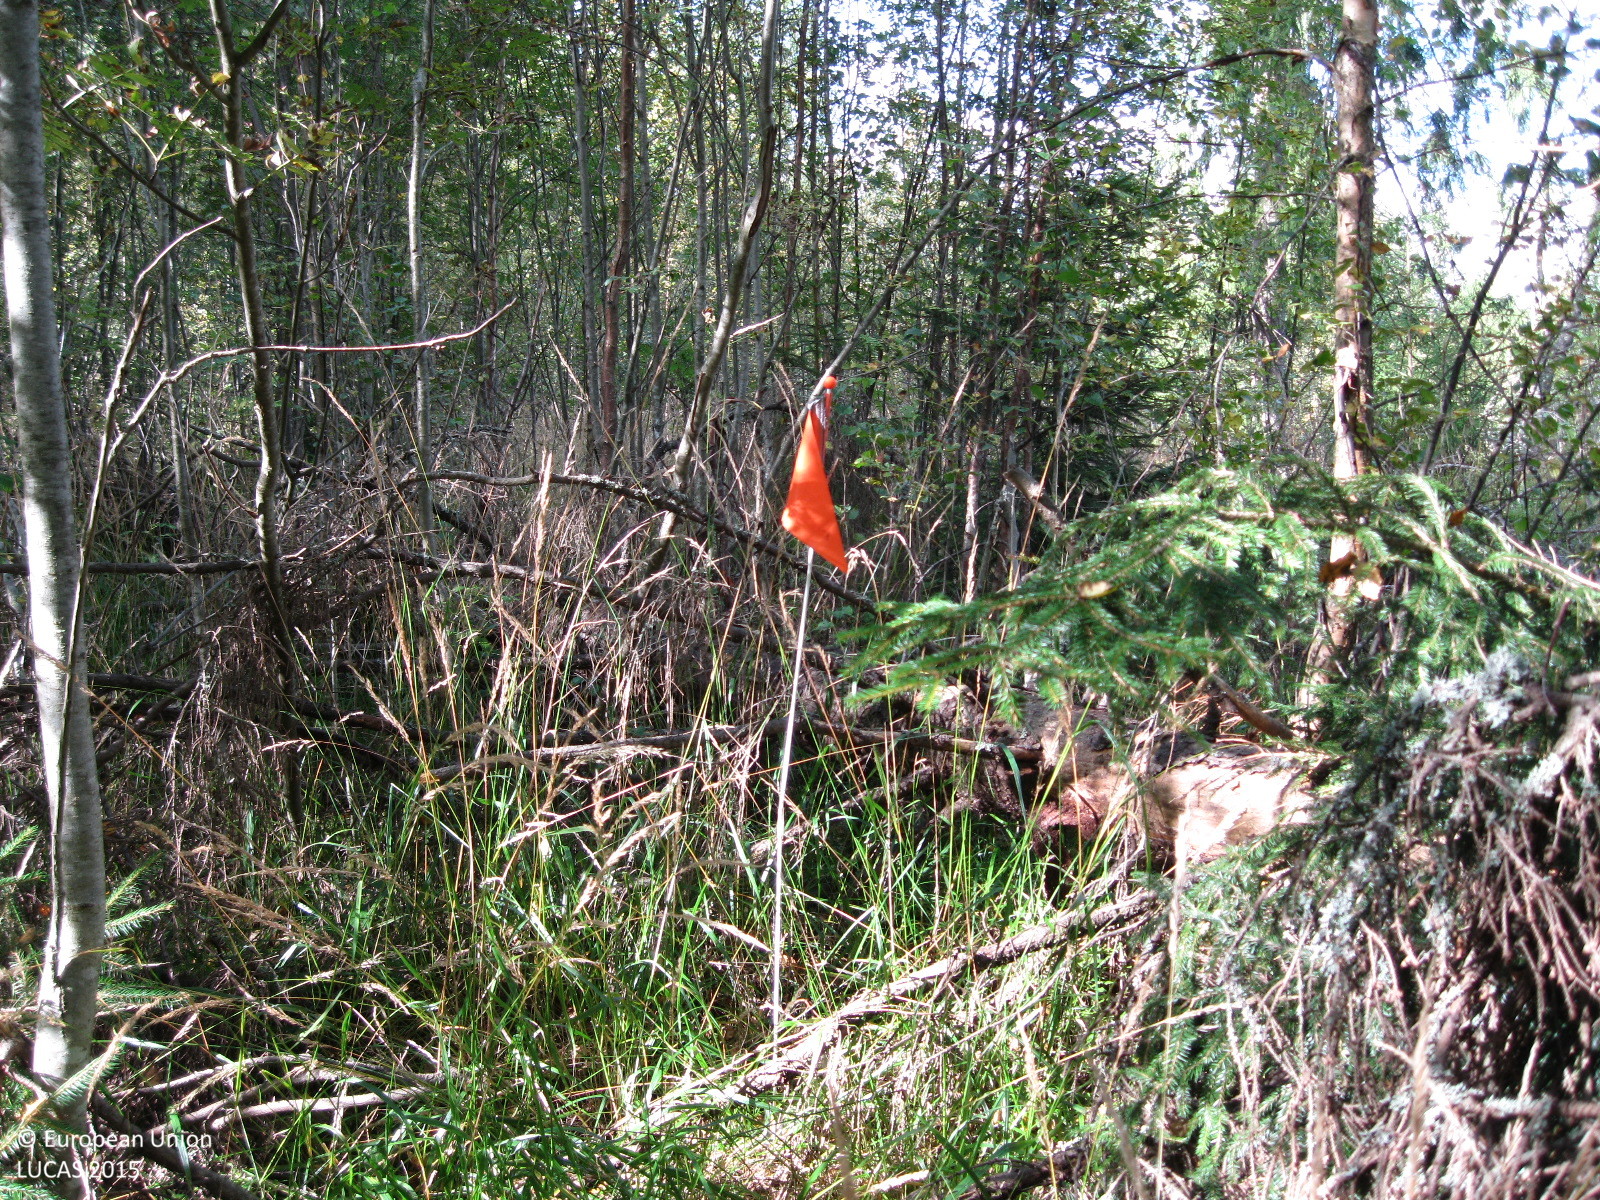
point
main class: Woodland
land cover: Broadleaved woodland
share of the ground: > 75 %
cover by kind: broadleaved forest trees 90 %, shrubs 5 %, herbaceous plants 5 %
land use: Forestry
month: September
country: FI
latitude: 60.3773
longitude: 24.5267
